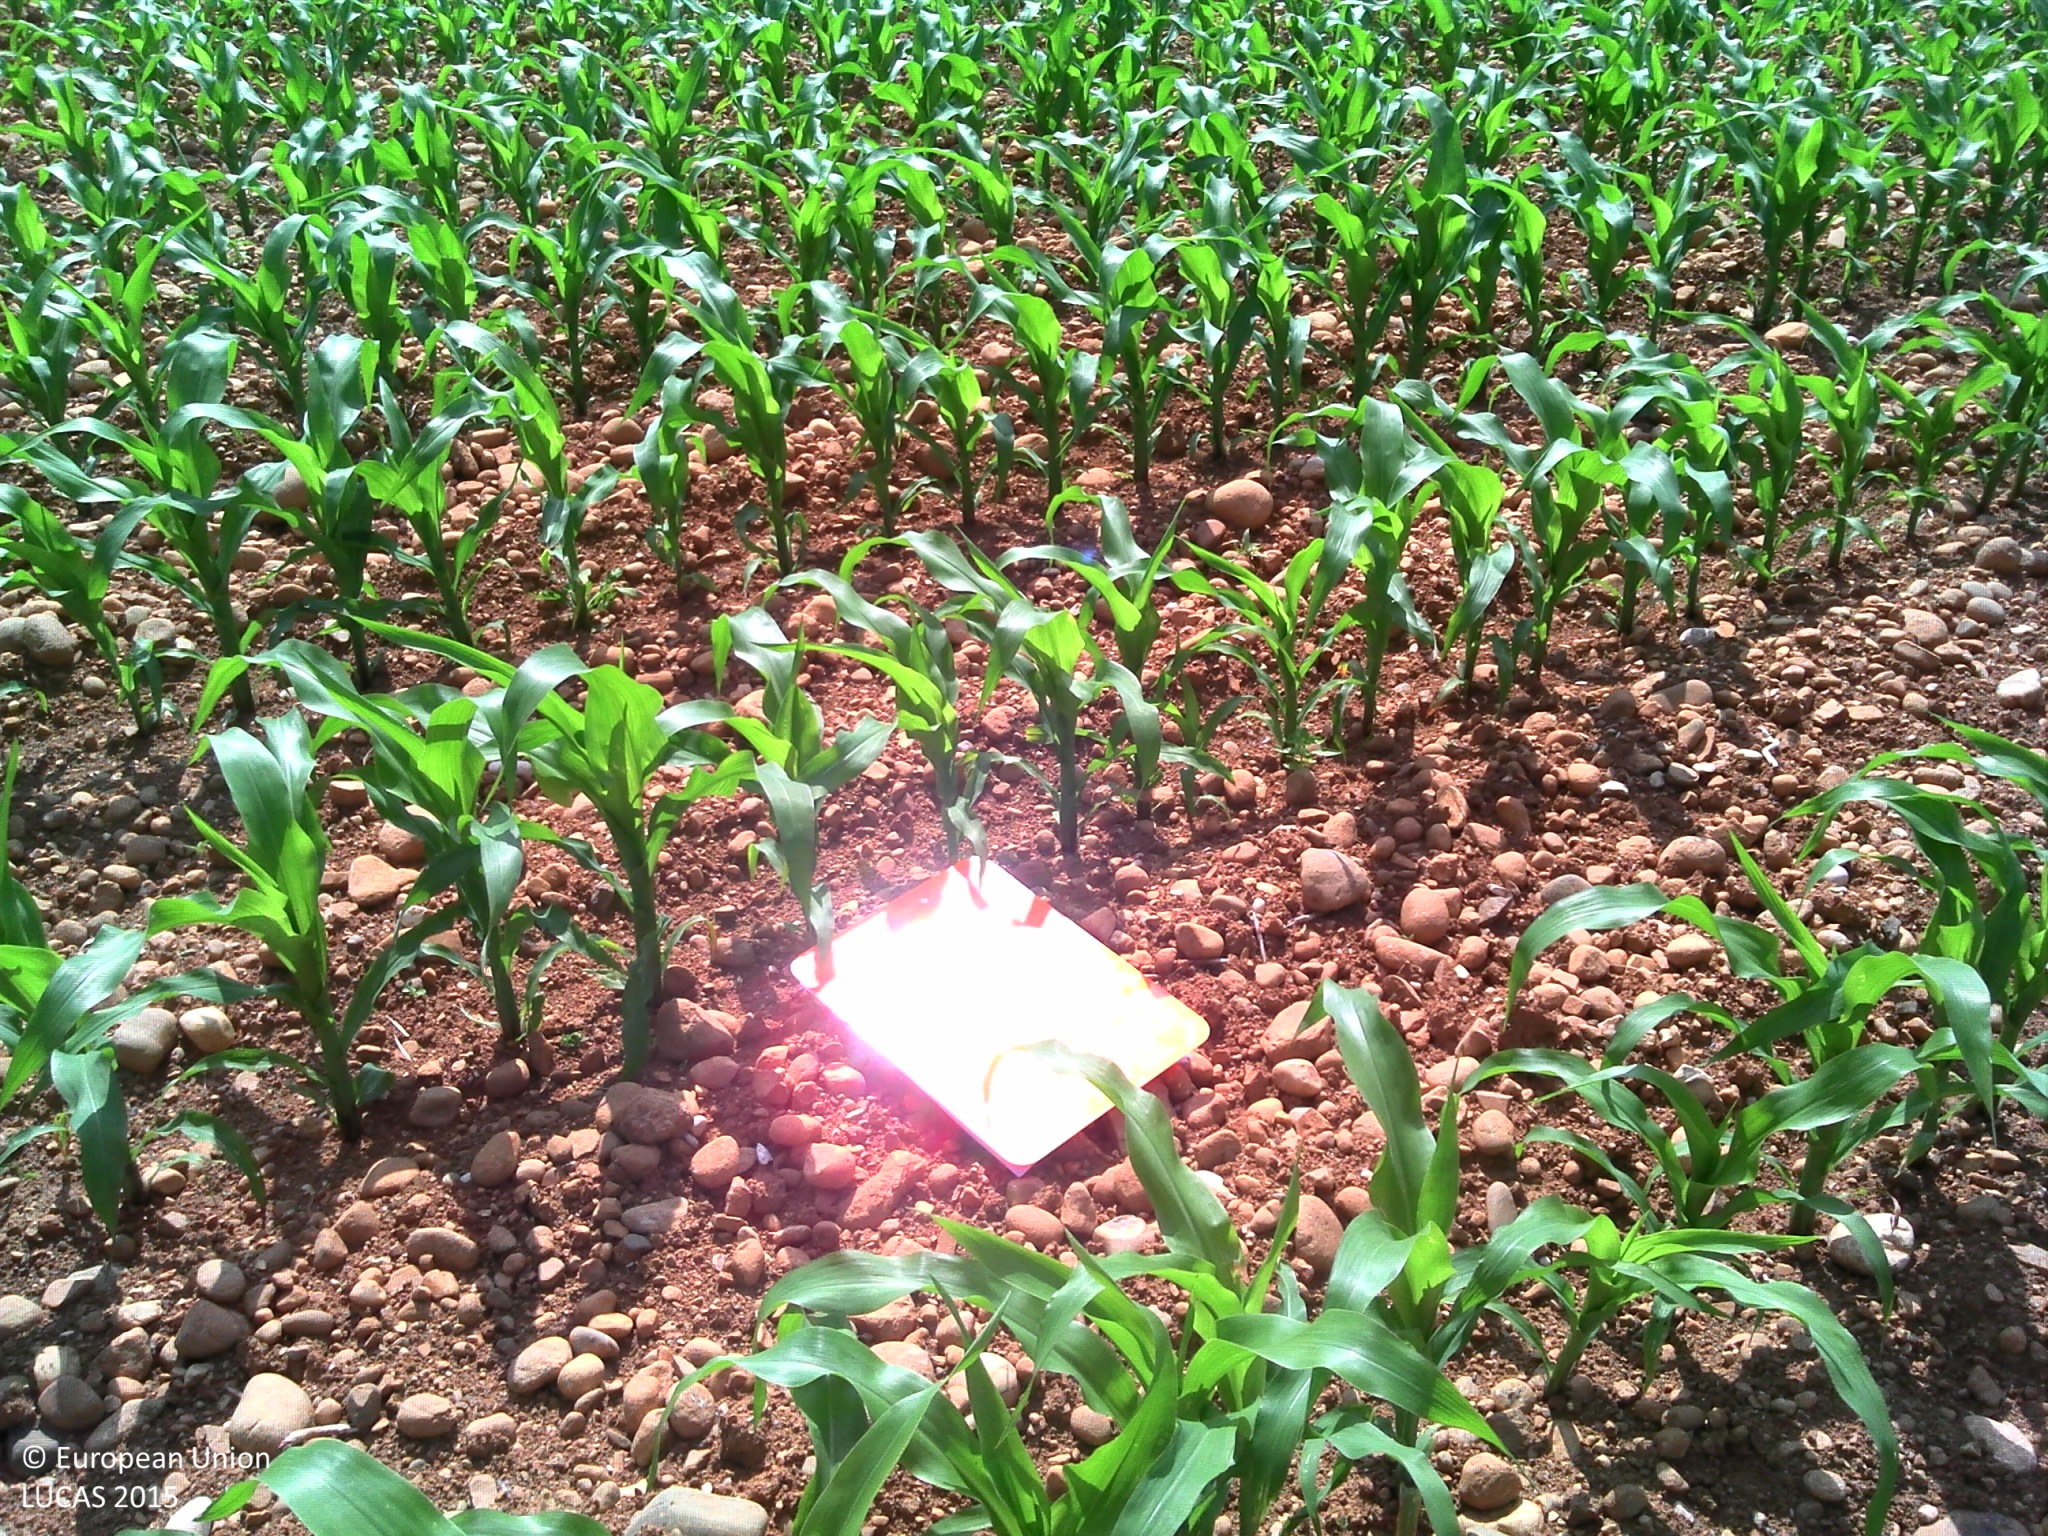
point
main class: Cropland
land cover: Maize
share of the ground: 10 - 25 %
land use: Agriculture (excluding fallow land and kitchen gardens)
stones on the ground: > 50 %
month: May
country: FR
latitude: 45.0699
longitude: 5.1917
